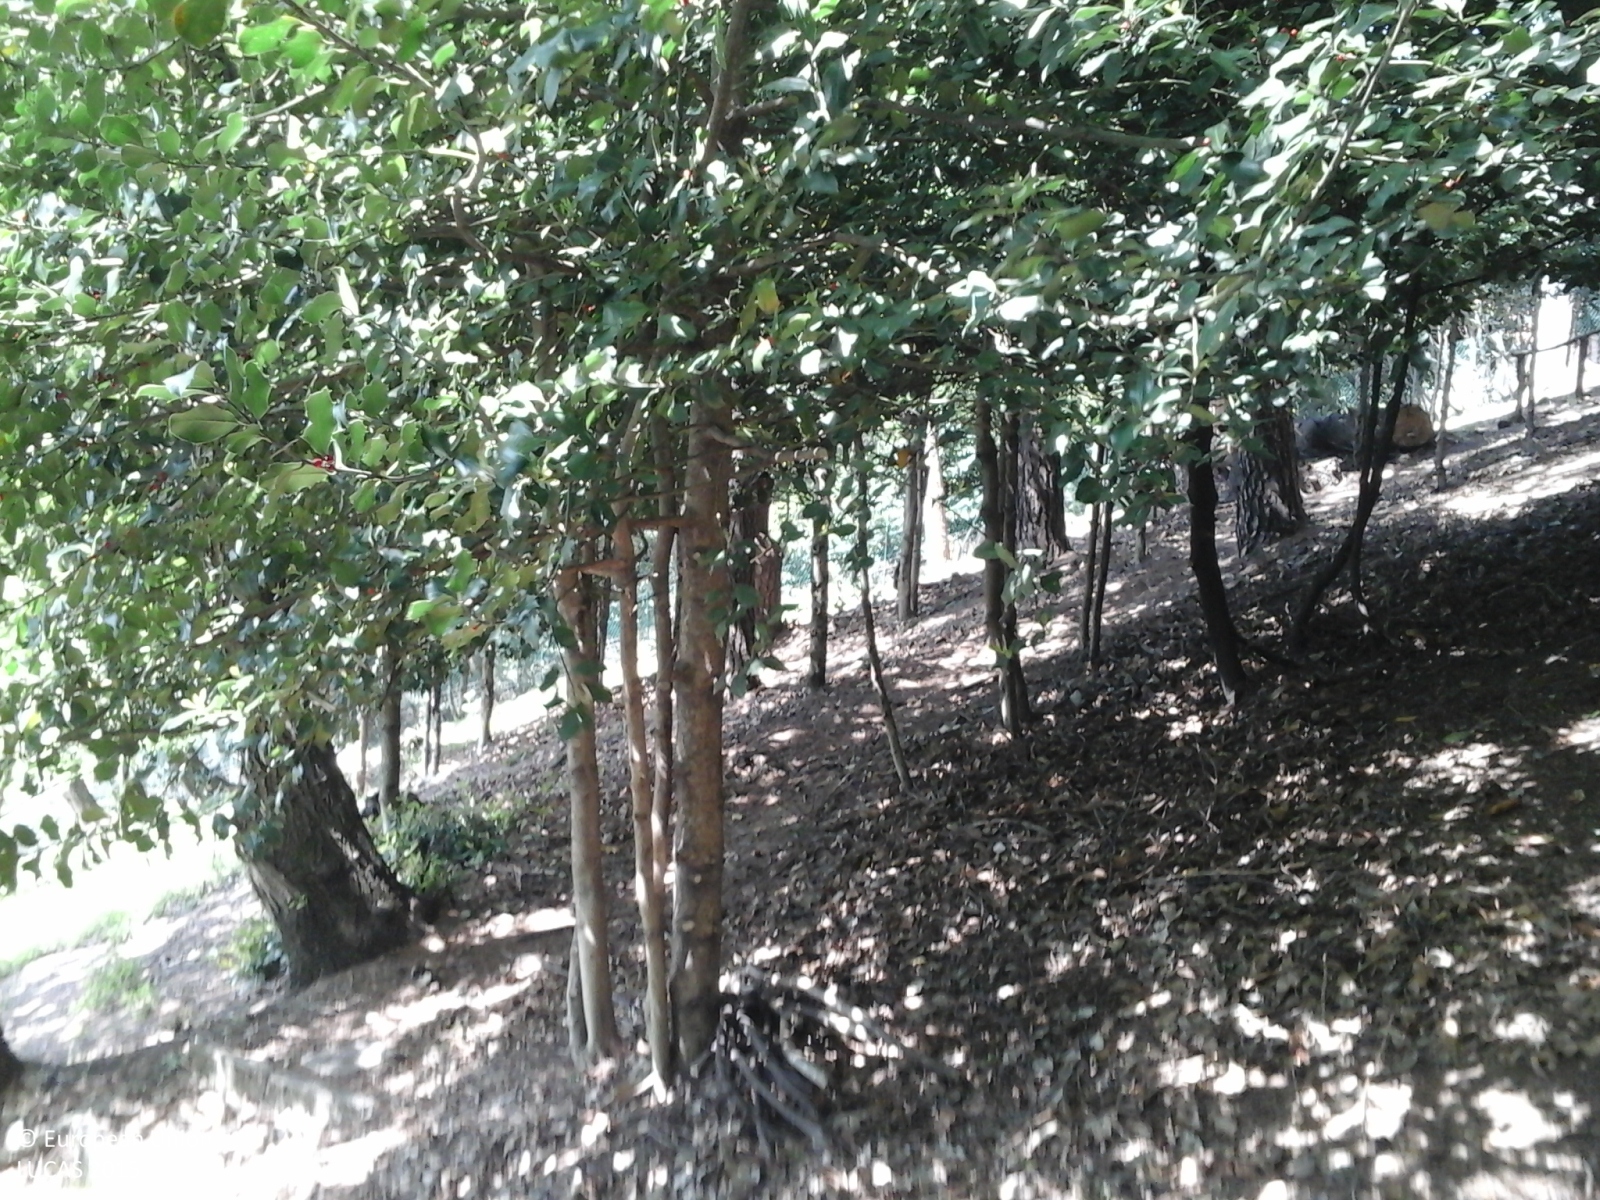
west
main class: Woodland
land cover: Other mixed woodland
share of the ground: > 75 %
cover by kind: coniferous forest trees 50 %, broadleaved forest trees 30 %, shrubs 10 %, unconsolidated bare surface 10 %
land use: Forestry
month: May
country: IT
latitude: 45.8250
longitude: 9.1132
